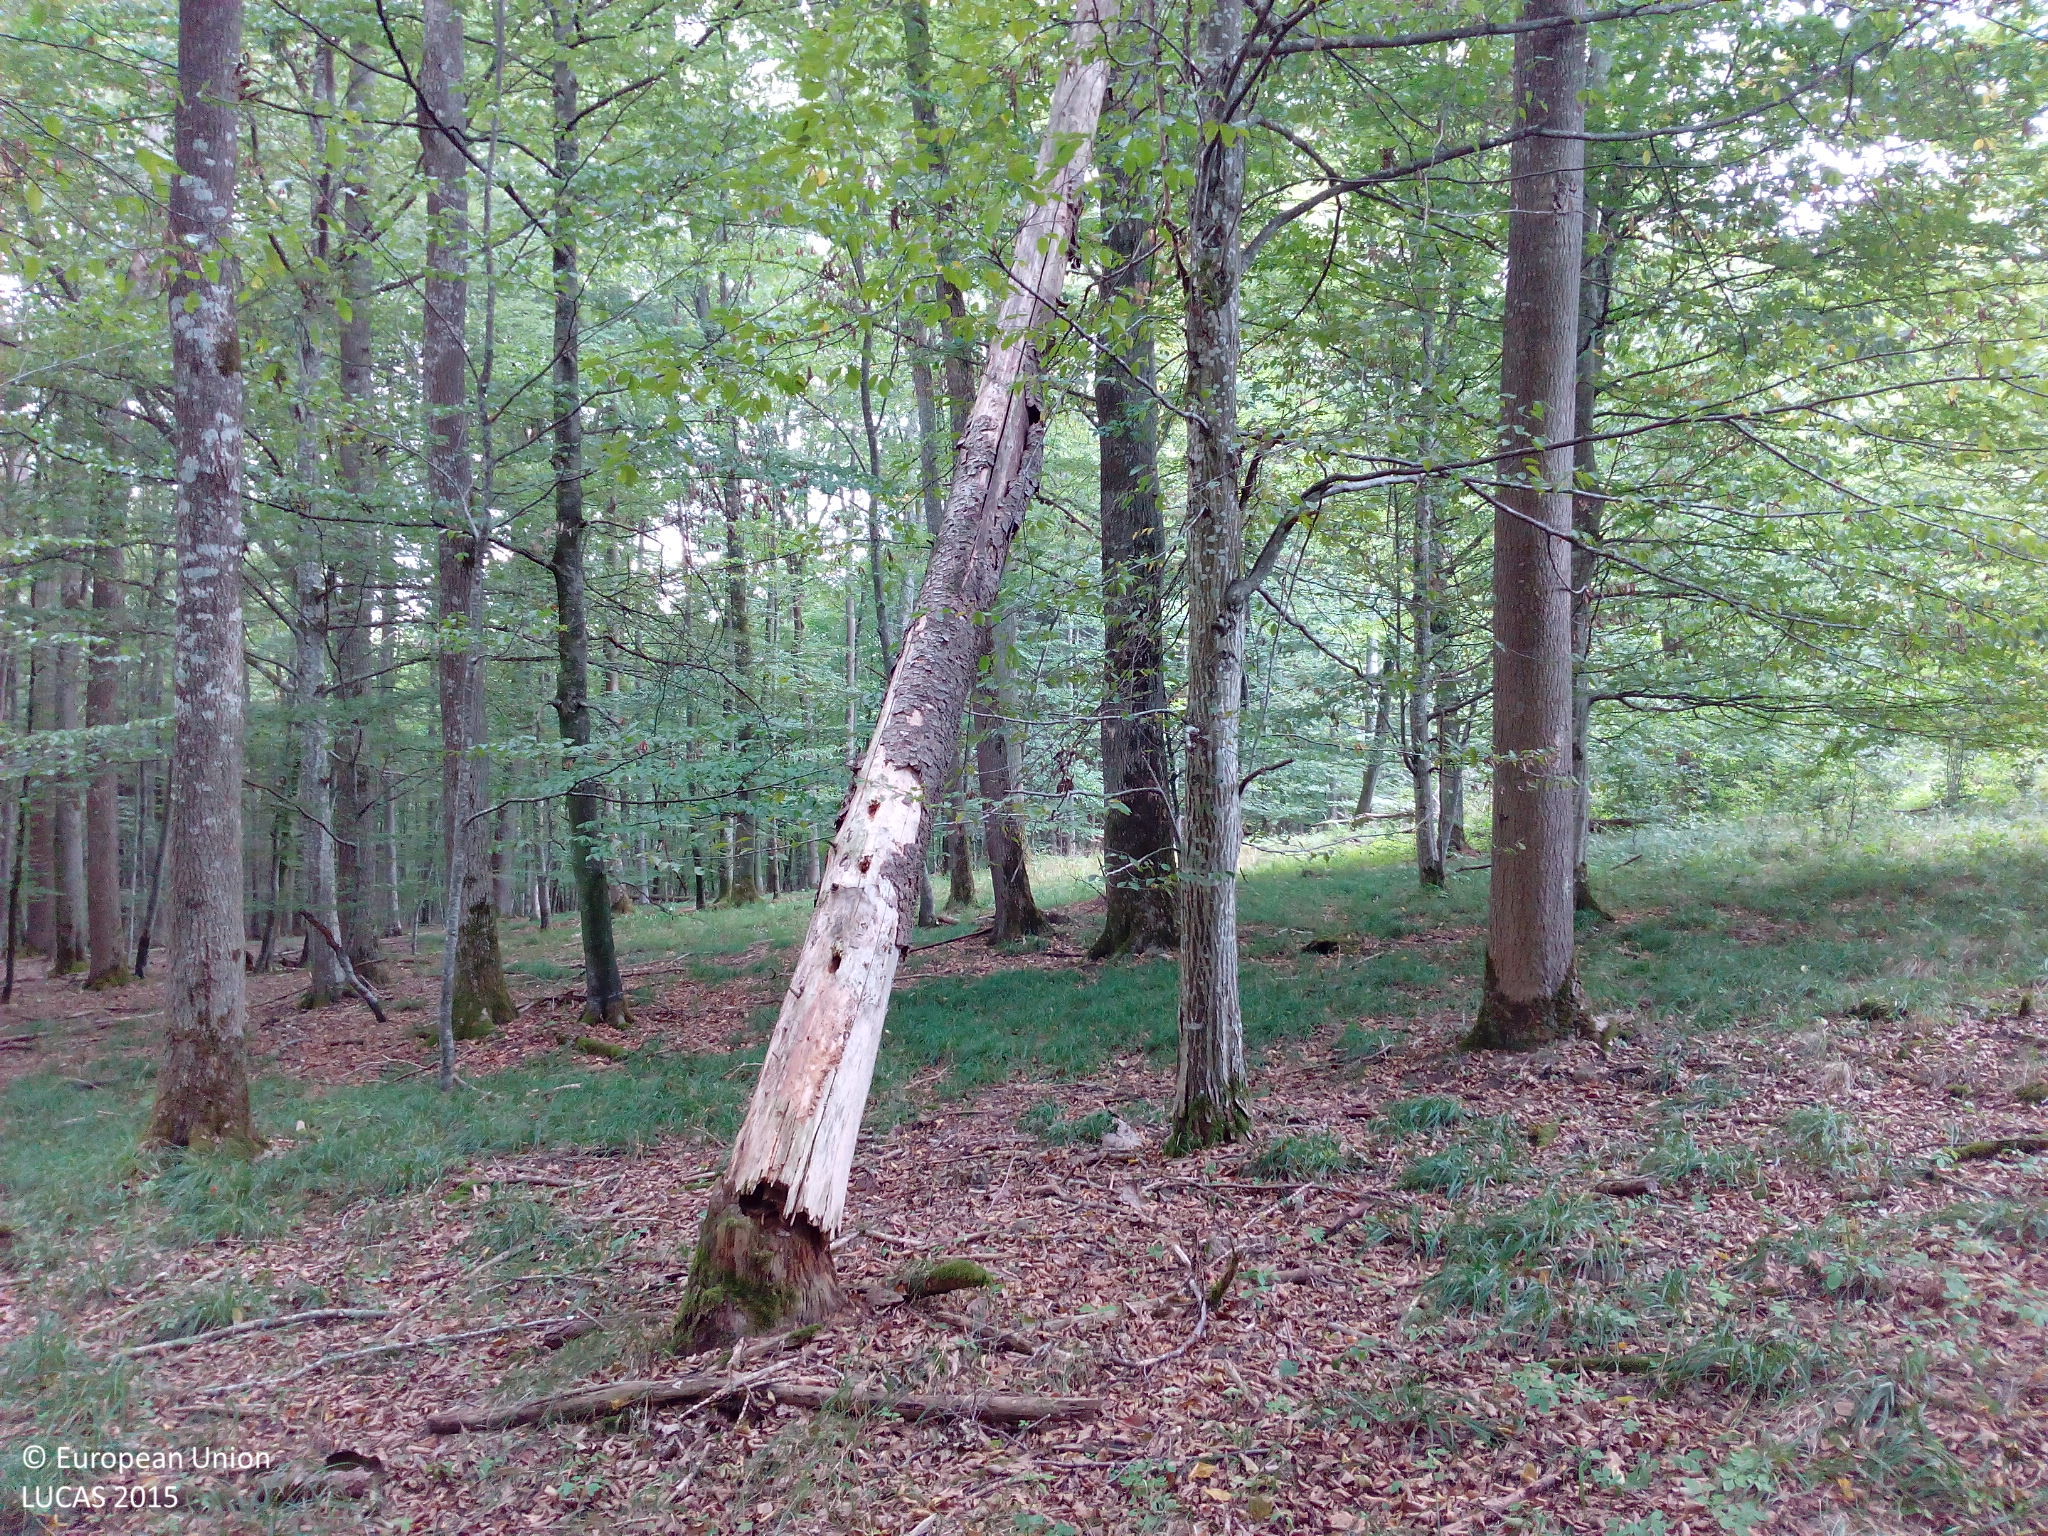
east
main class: Woodland
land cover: Broadleaved woodland
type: mesophytic deciduous forest
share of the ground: > 75 %
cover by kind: broadleaved forest trees 80 %, coniferous forest trees 10 %, unconsolidated bare surface 10 %
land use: Forestry
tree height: > 5 m
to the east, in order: Broadleaved woodland
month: September
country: DE
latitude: 48.6721
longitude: 10.5293
